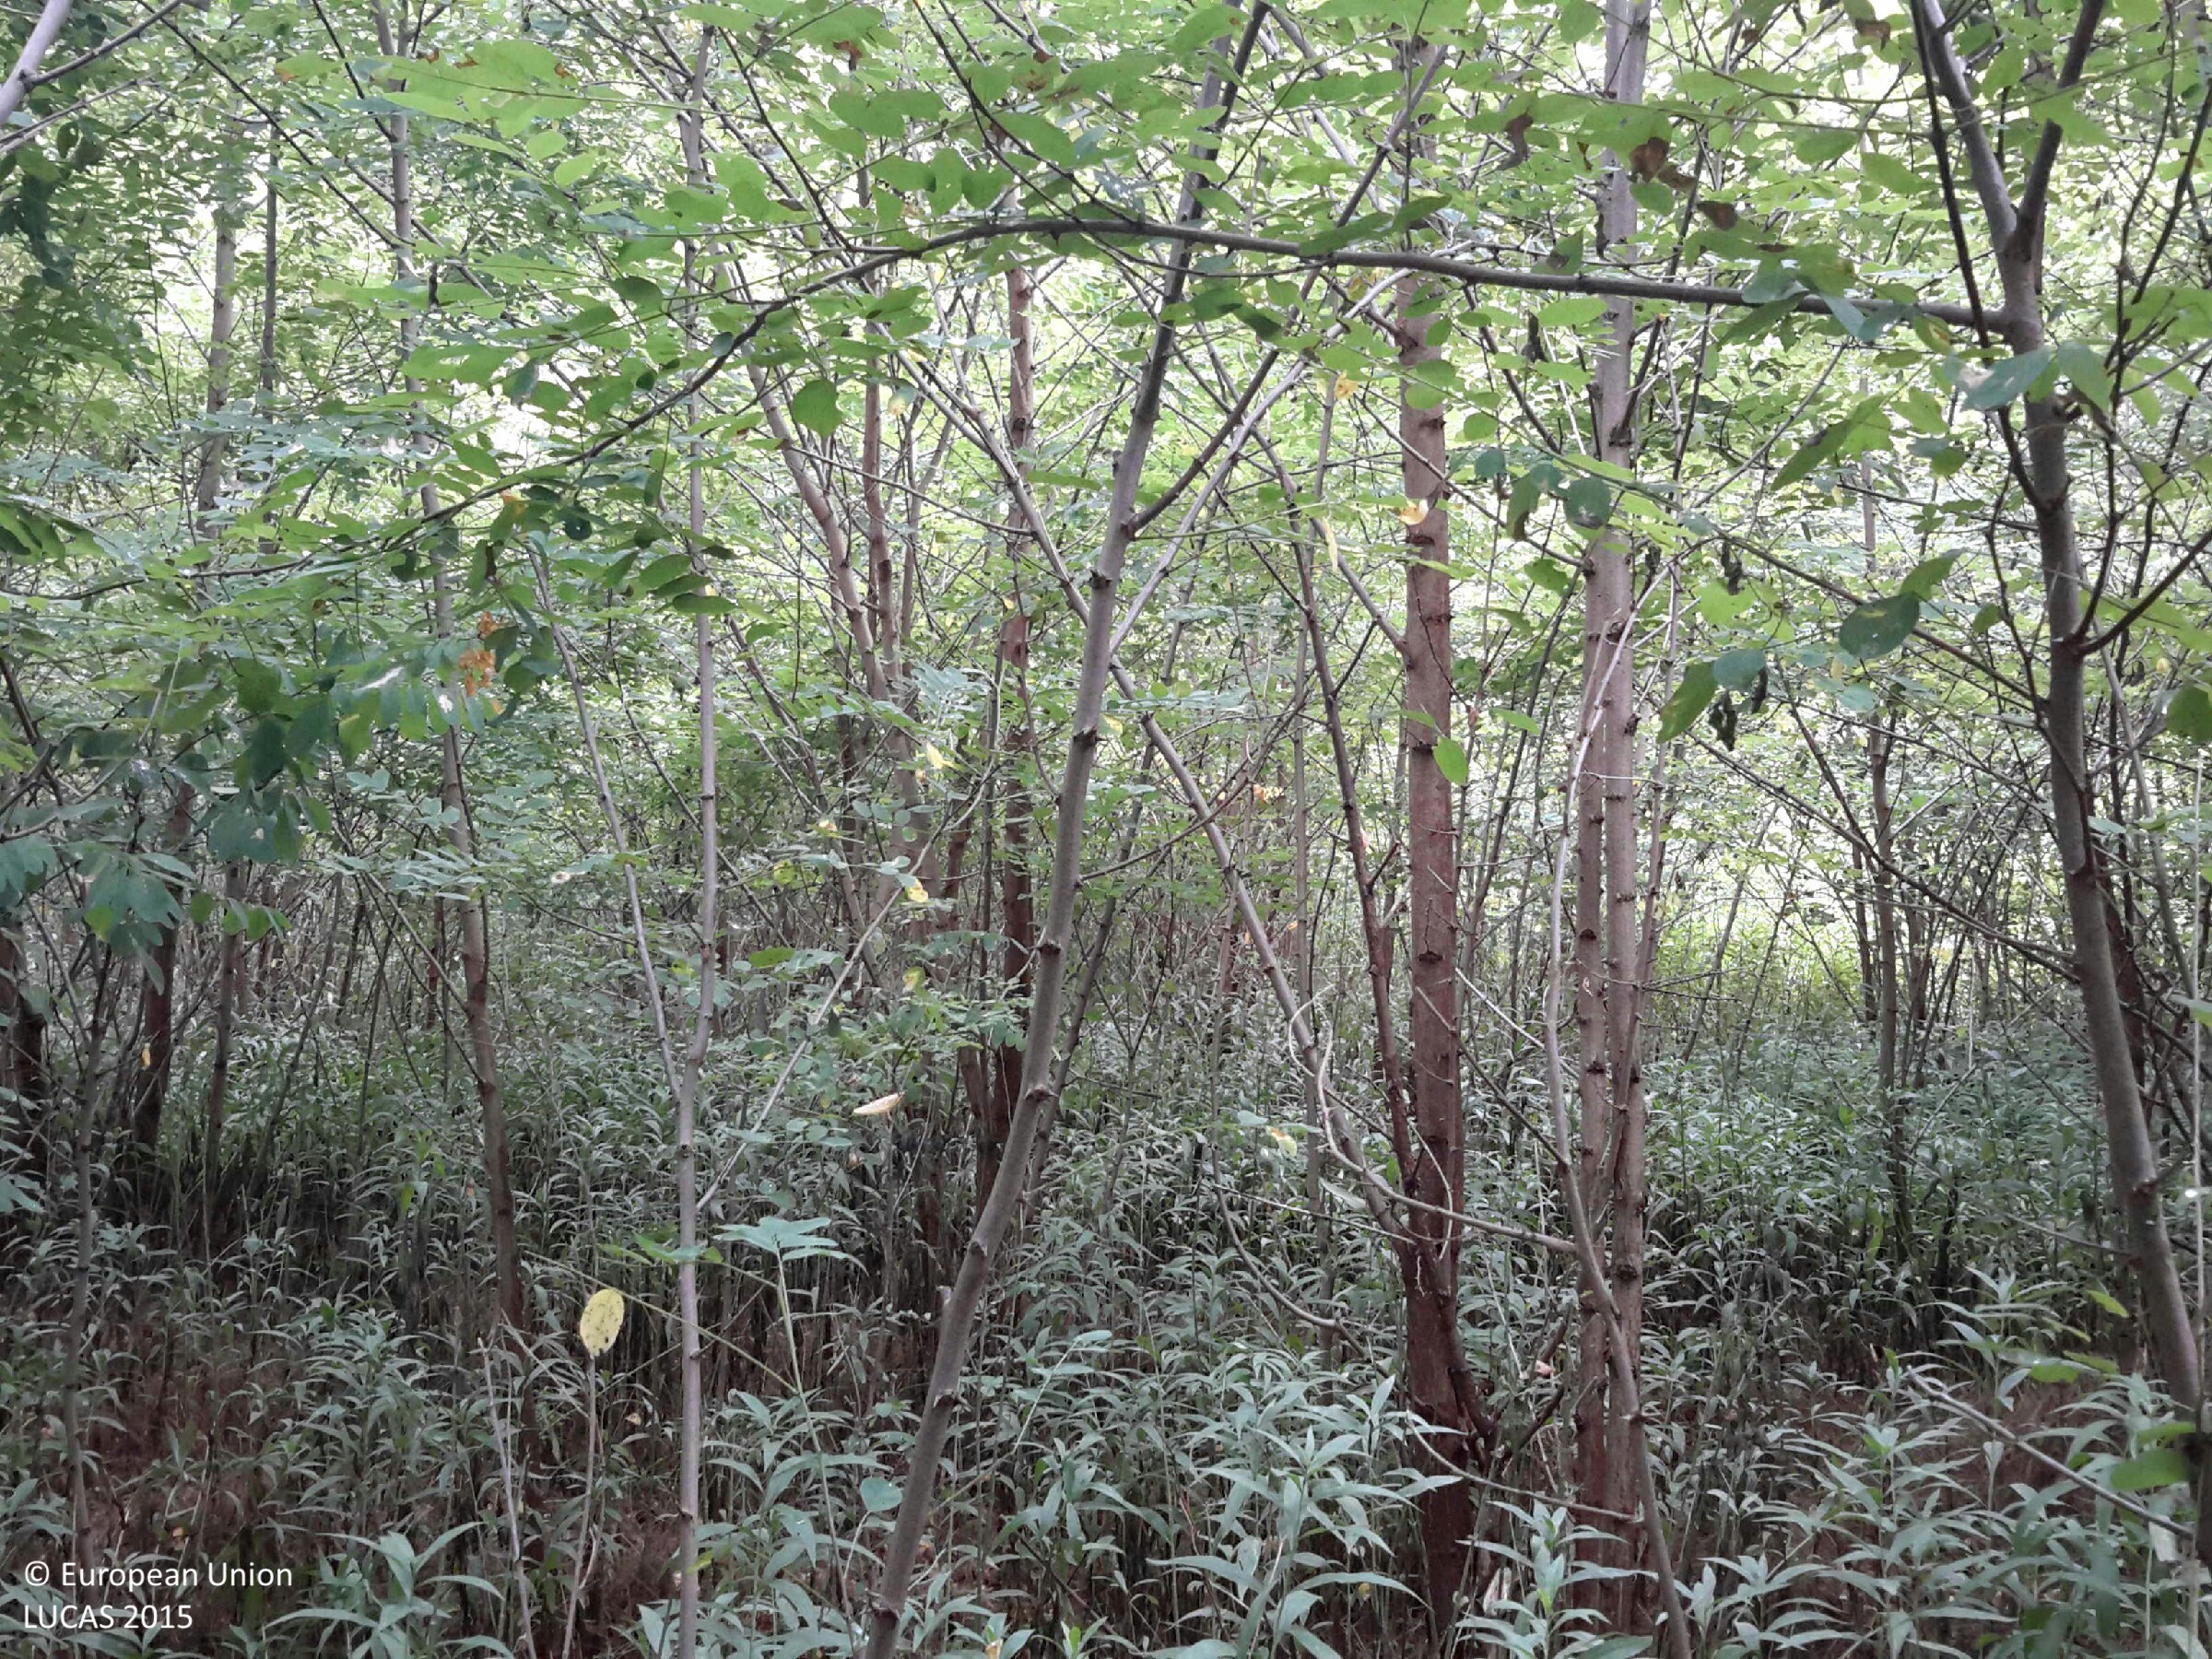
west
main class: Woodland
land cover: Broadleaved woodland
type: exotic forest
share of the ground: > 75 %
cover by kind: broadleaved forest trees 60 %, shrubs 35 %, herbaceous plants 5 %
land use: Forestry
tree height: > 5 m
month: July
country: HU
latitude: 47.5529
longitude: 17.4896
